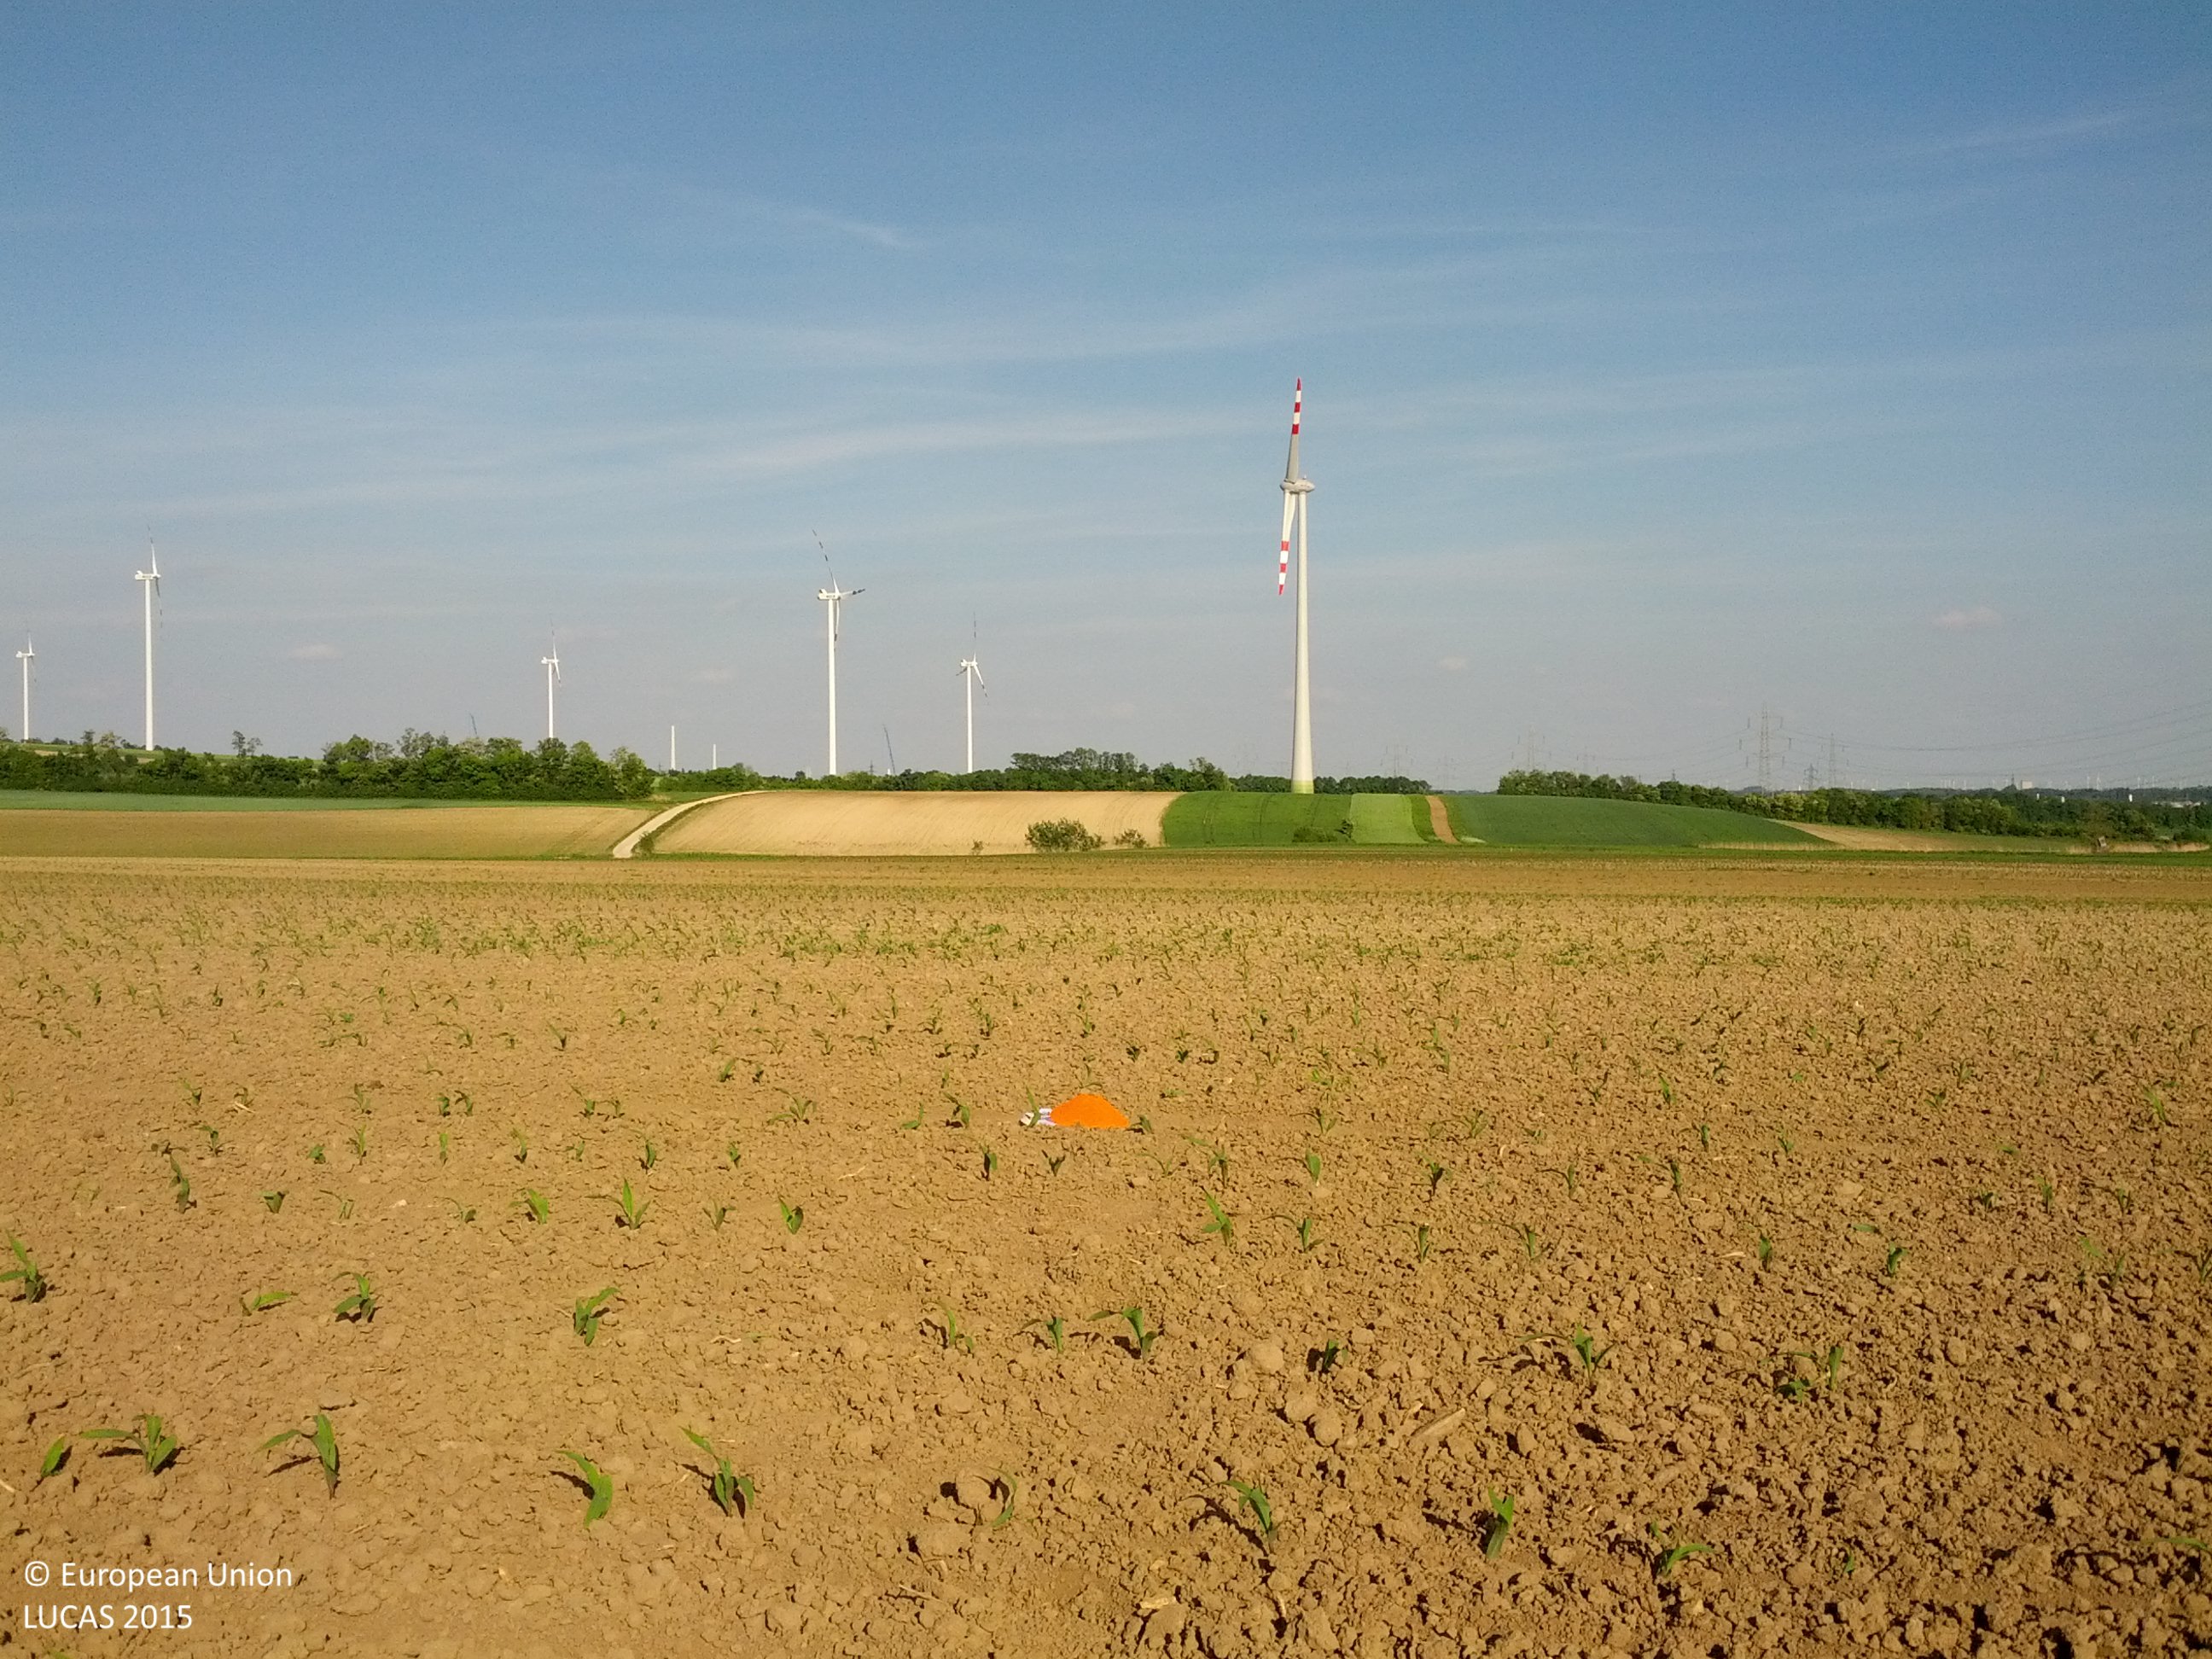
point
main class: Cropland
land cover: Maize
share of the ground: < 10 %
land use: Agriculture (excluding fallow land and kitchen gardens)
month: May
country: AT
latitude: 48.0524
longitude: 16.7545
